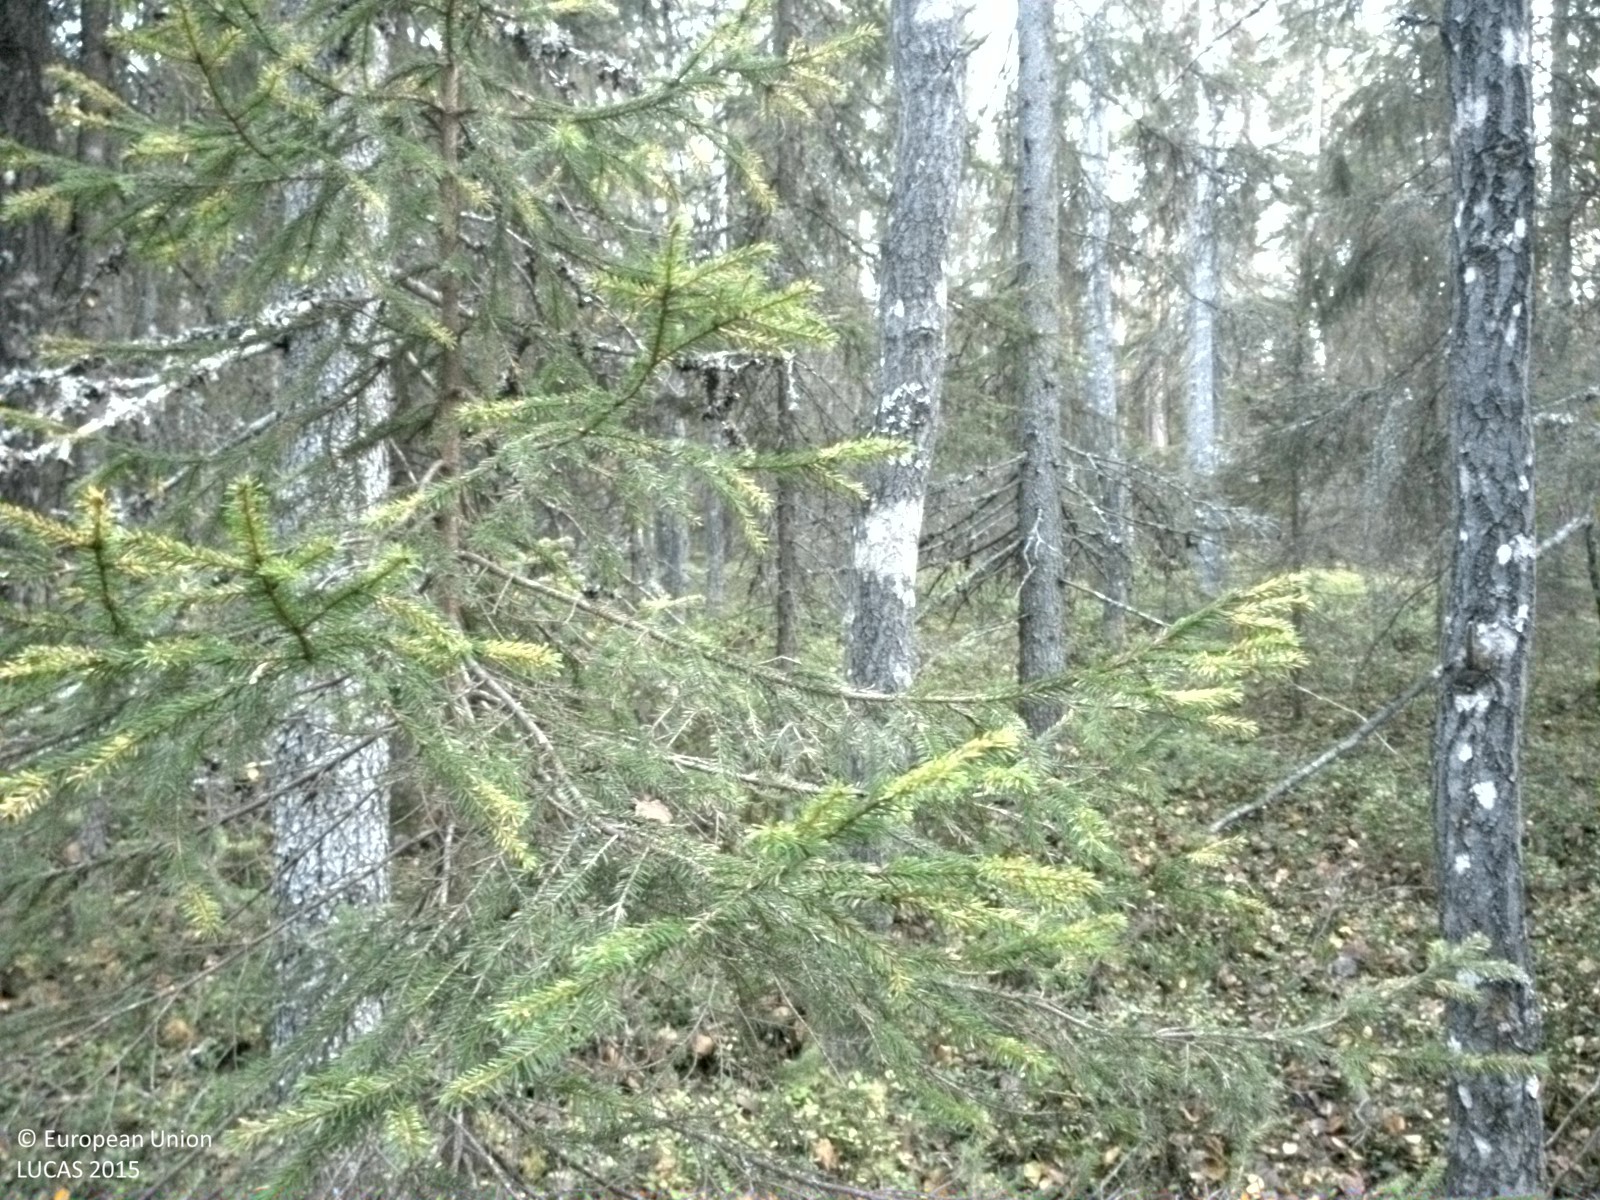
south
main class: Woodland
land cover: Spruce dominated mixed woodland
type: boreal forest
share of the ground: 50 - 75 %
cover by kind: shrubs 40 %, coniferous forest trees 35 %, broadleaved forest trees 25 %
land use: Amenities, museums, leisure
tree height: > 5 m
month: October
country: SE
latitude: 65.5923
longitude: 21.9710
